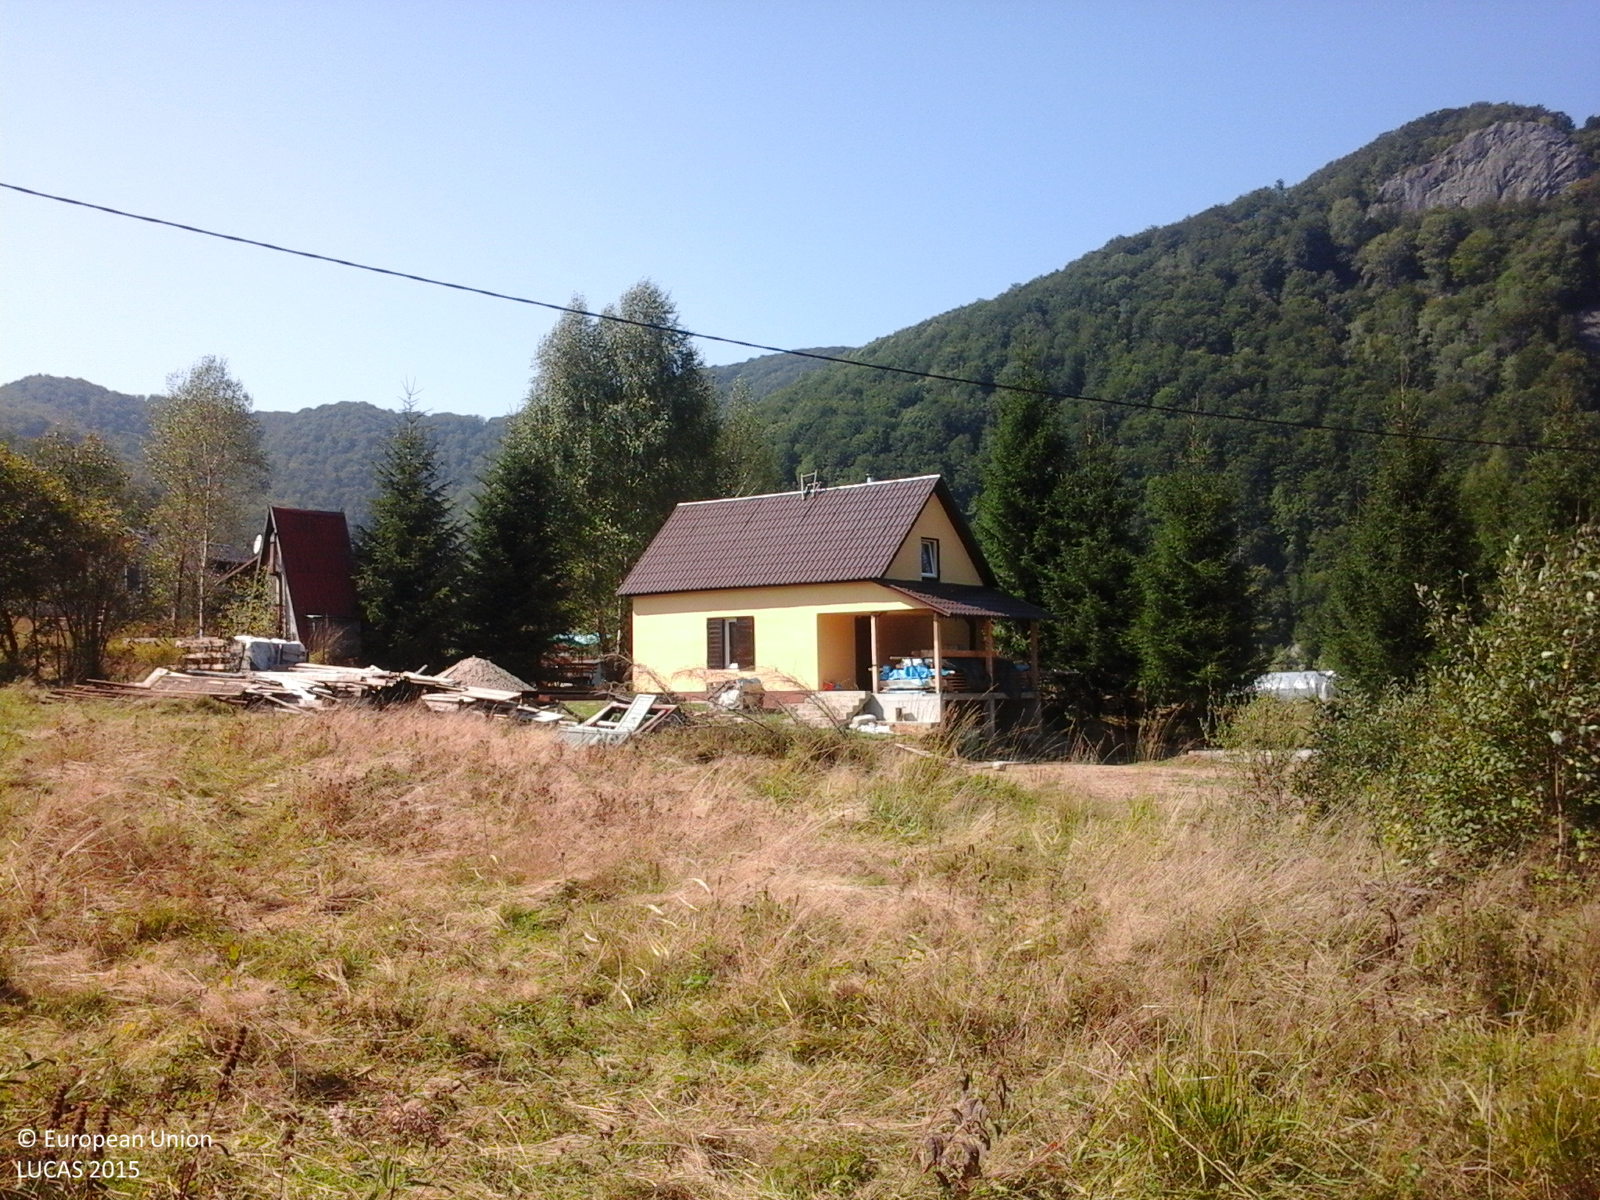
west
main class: Grassland
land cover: Grassland with sparse tree/shrub cover
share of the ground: > 75 %
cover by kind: herbaceous plants 85 %, shrubs 10 %, broadleaved forest trees 5 %
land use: Agriculture (excluding fallow land and kitchen gardens)
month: September
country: RO
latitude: 46.7910
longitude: 22.5648
